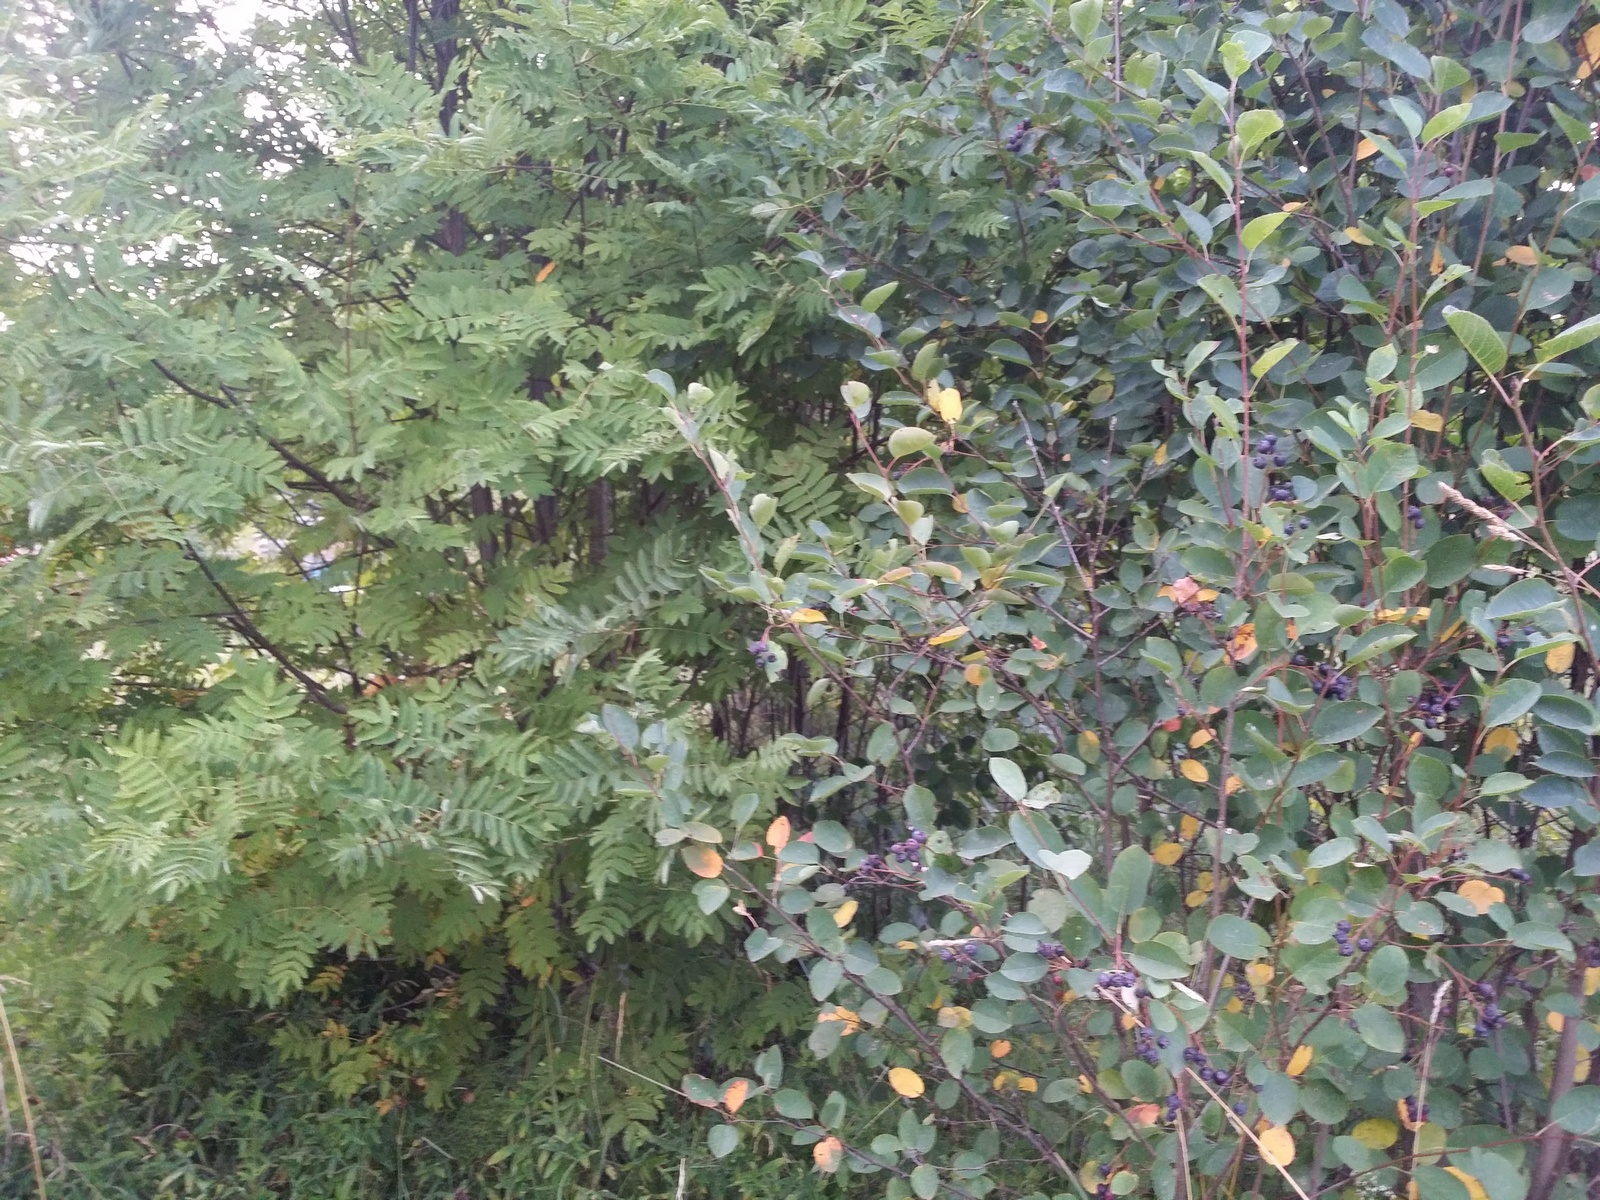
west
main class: Grassland
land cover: Spontaneously vegetated surfaces
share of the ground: > 75 %
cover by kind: herbaceous plants 100 %
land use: Semi-natural and natural areas not in use
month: August
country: LV
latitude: 57.3499
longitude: 26.8220
